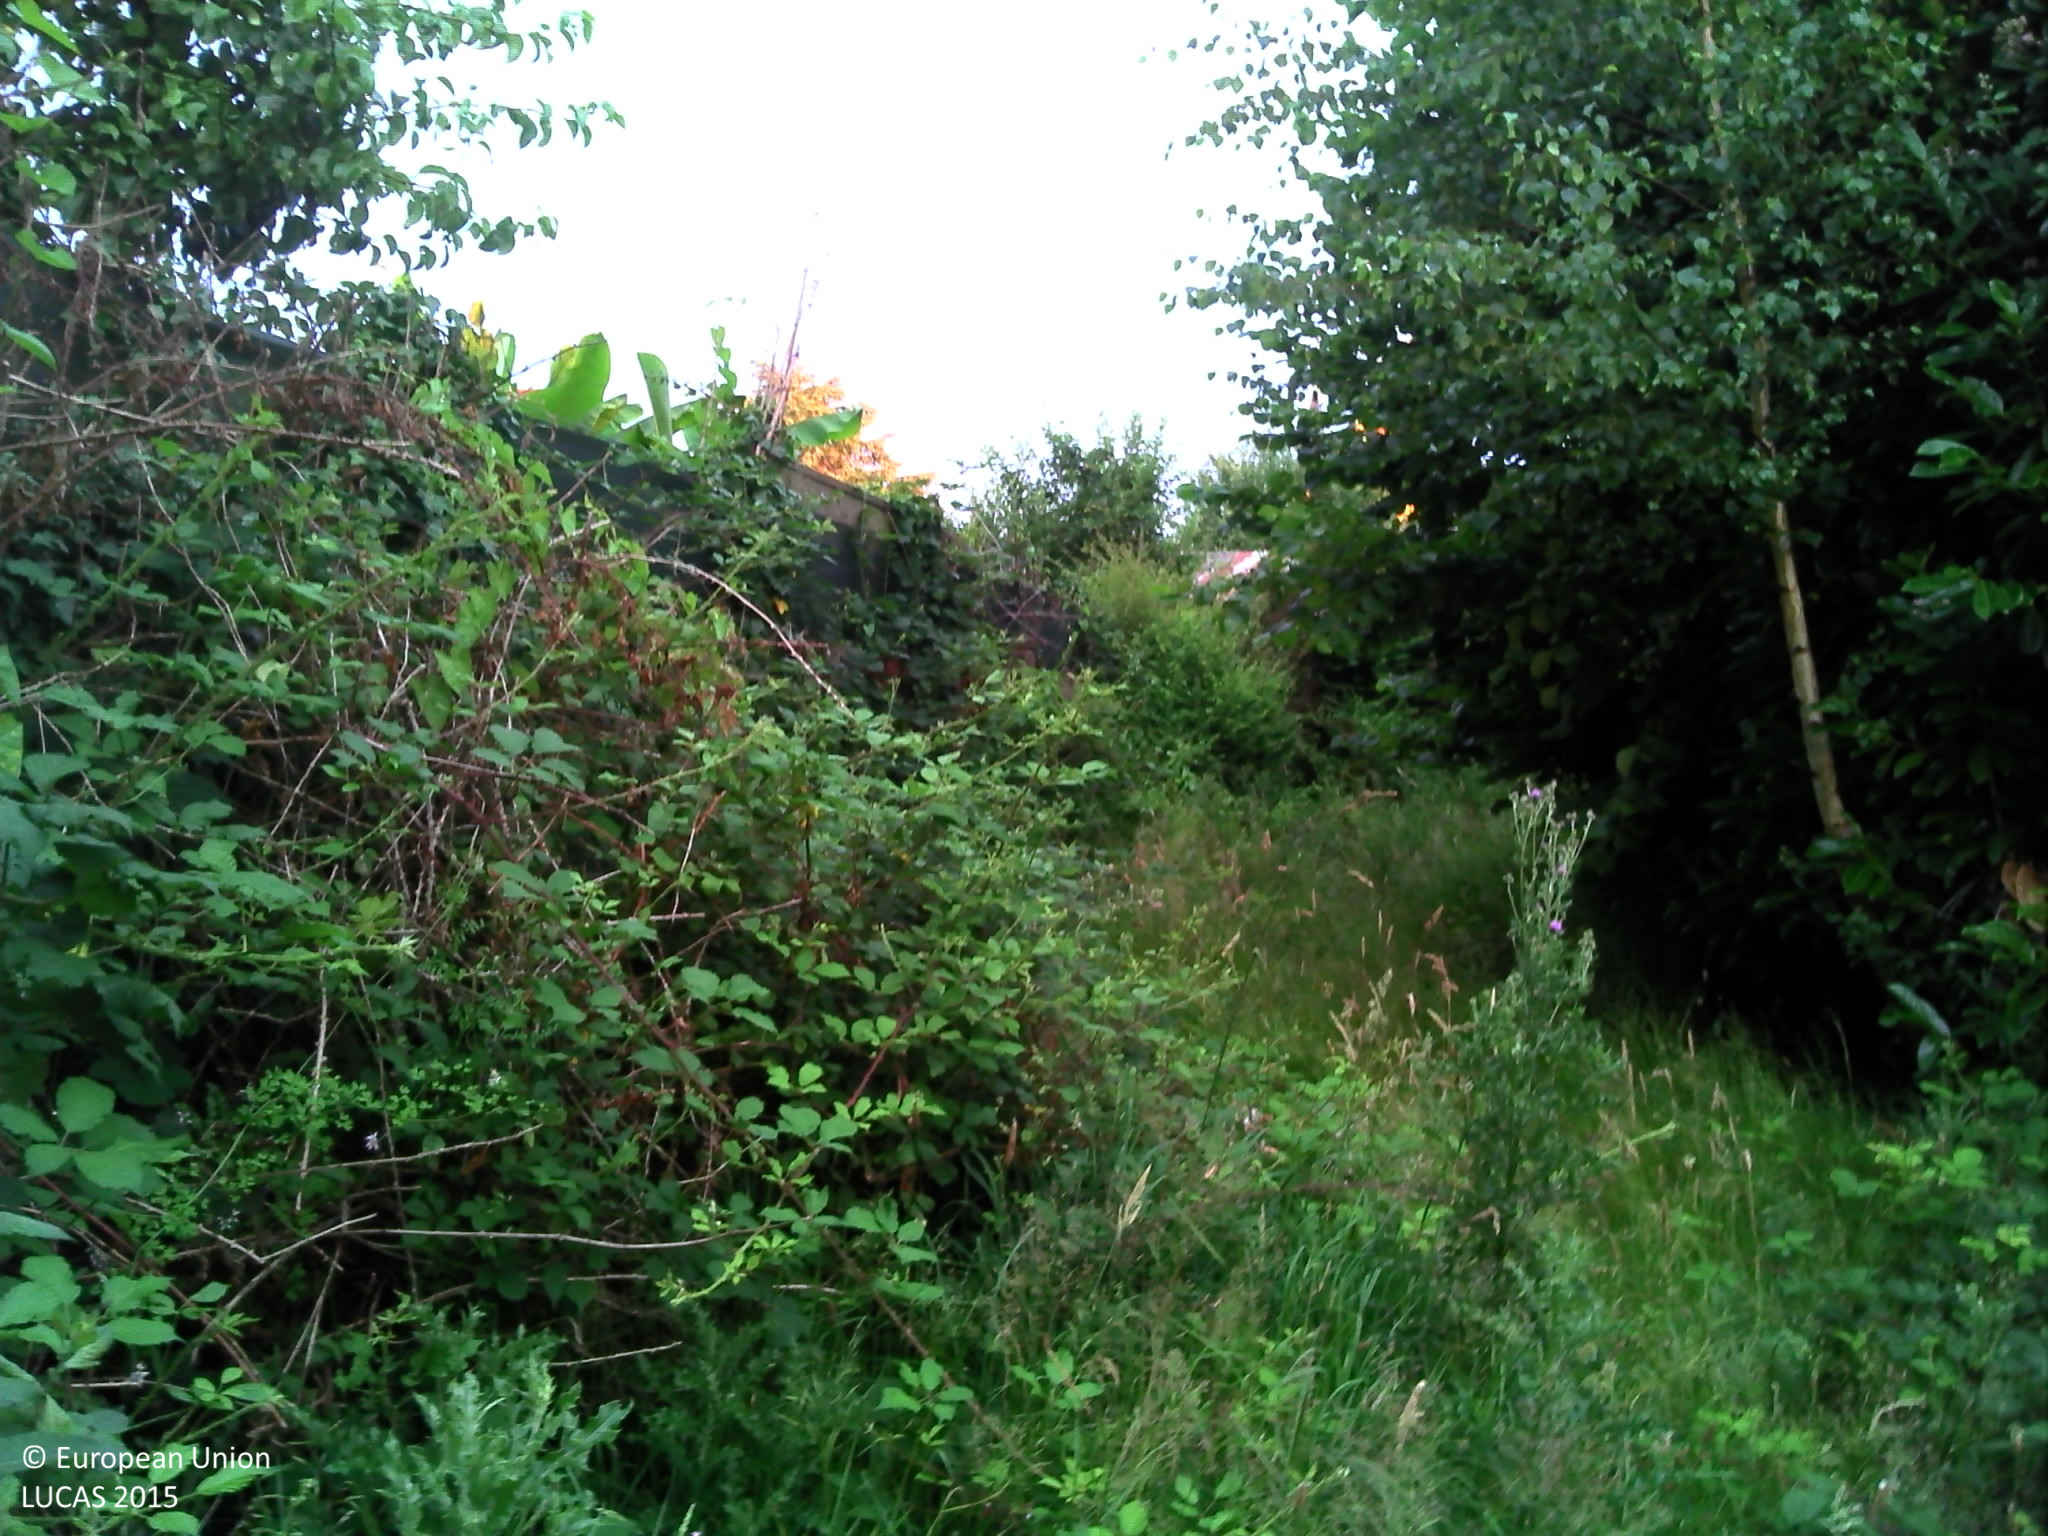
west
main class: Woodland
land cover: Broadleaved woodland
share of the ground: > 75 %
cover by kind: broadleaved forest trees 50 %, shrubs 25 %, herbaceous plants 25 %
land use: Abandoned areas
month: July
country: FR
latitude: 48.3438
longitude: -1.1734
